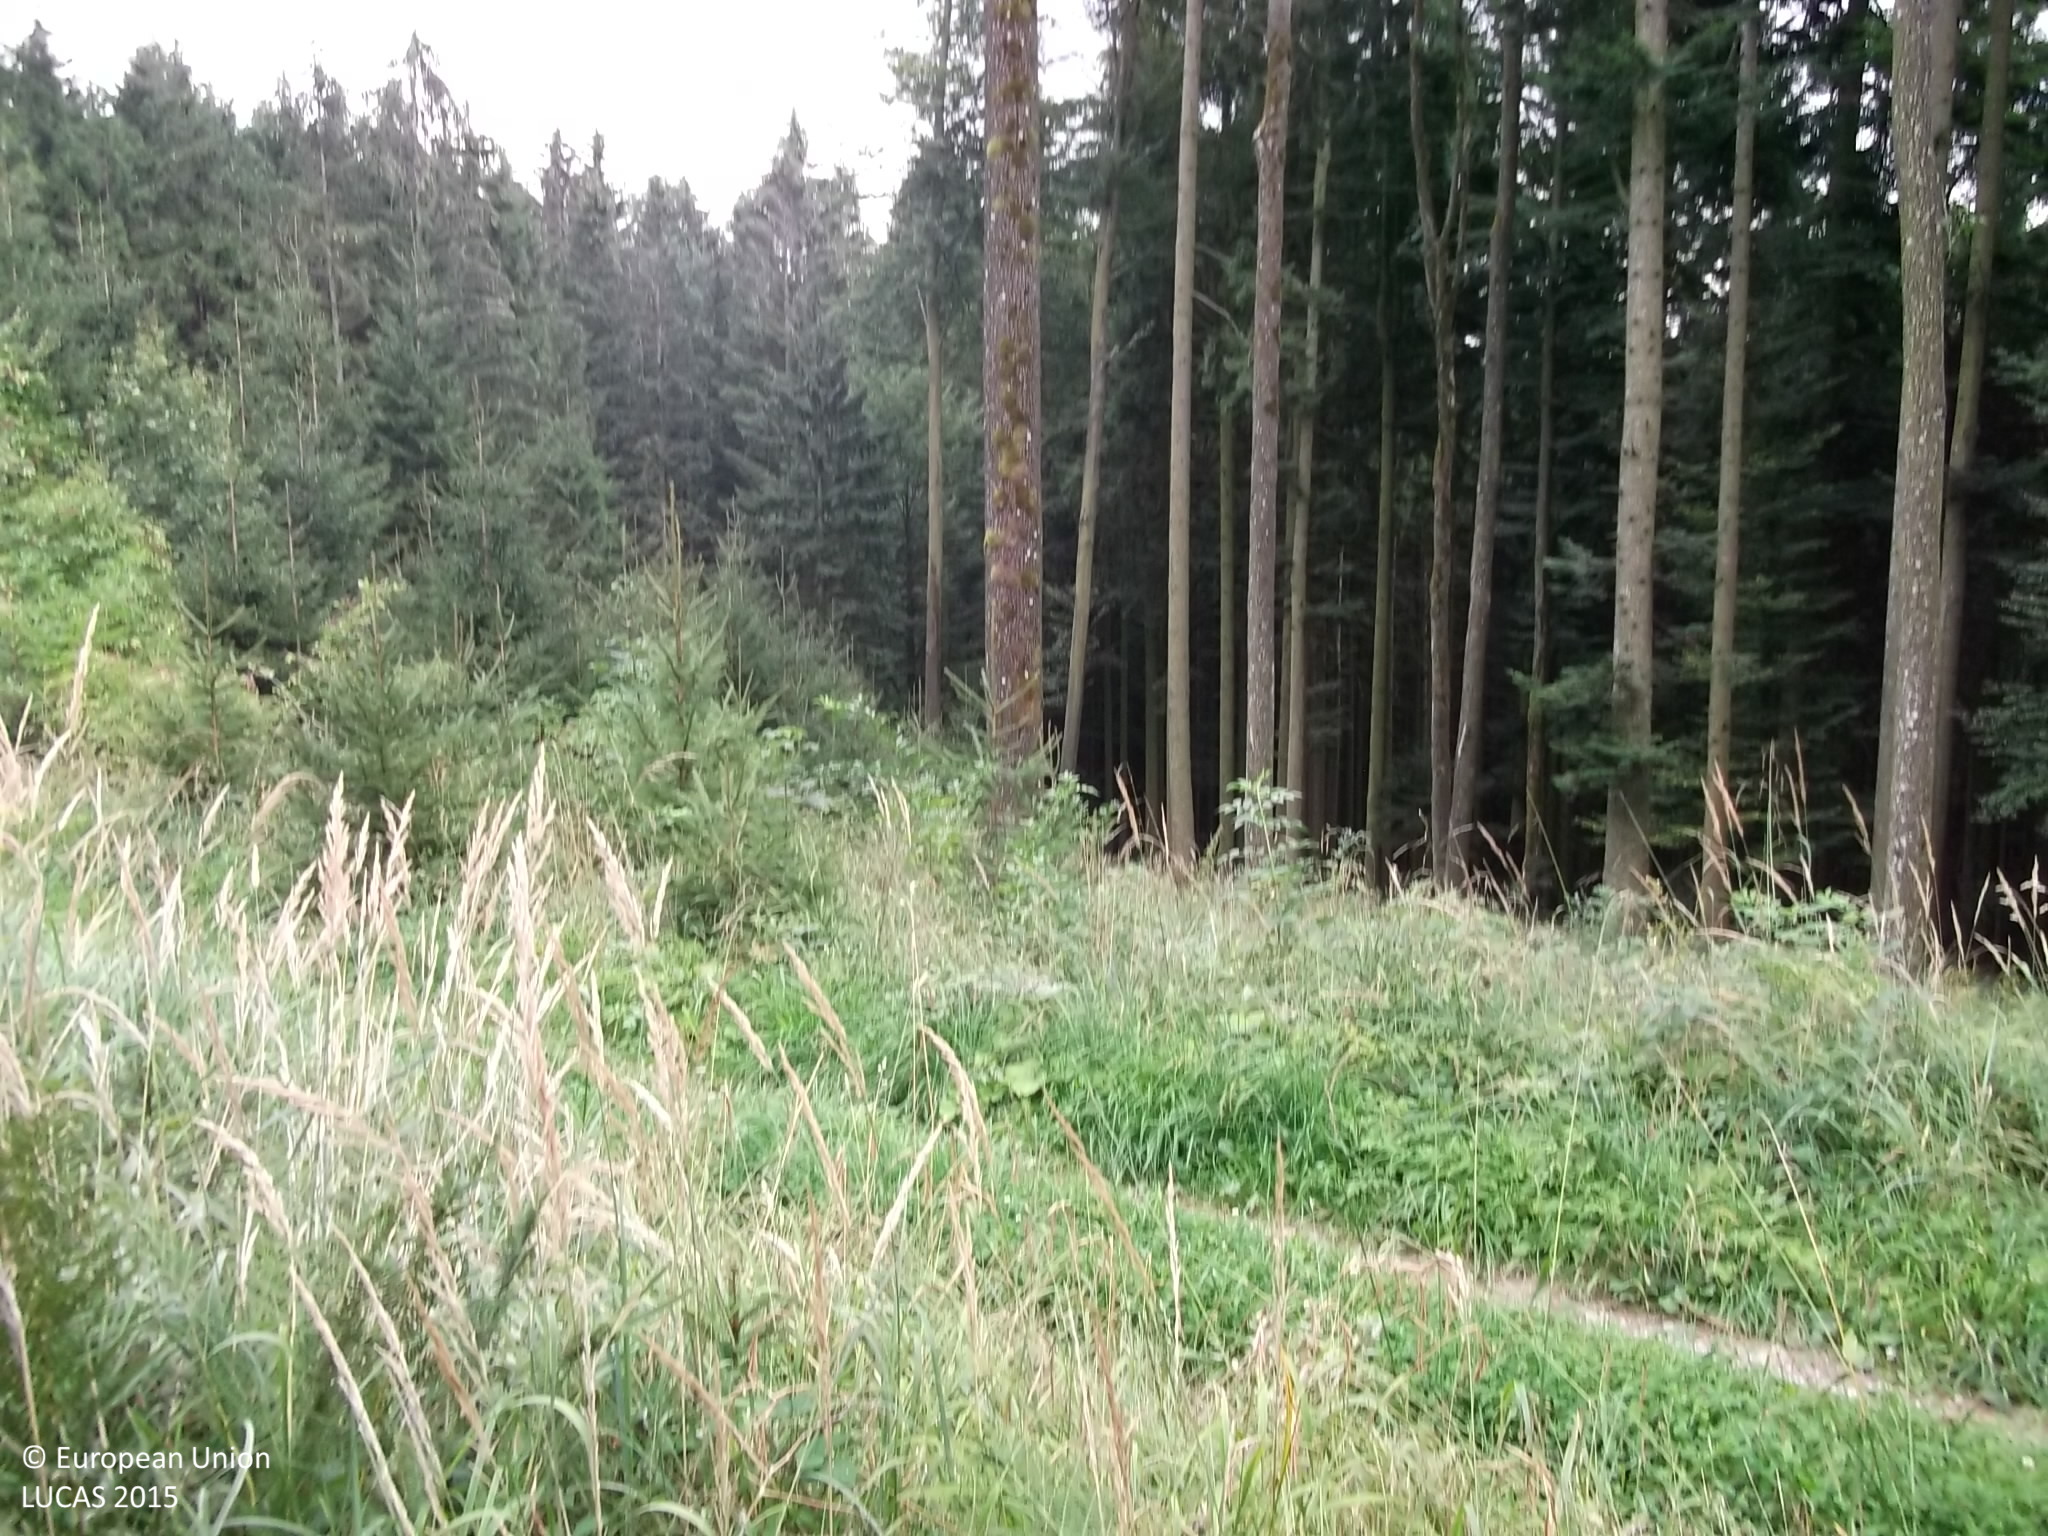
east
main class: Woodland
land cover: Spruce dominated coniferous woodland
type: alpine coniferous forest
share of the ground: > 75 %
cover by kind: coniferous forest trees 85 %, shrubs 10 %, herbaceous plants 5 %
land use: Forestry
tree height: < 5 m
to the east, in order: Spruce dominated coniferous woodland; Grass margins; Tracks; Shrubland with sparse tree cover; Tracks; Spruce dominated mixed woodland; Spruce dominated coniferous woodland; Rivers and streams; Spruce dominated mixed woodland; Fences; Grassland without tree/shrub cover
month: August
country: AT
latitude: 47.9571
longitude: 13.3334
